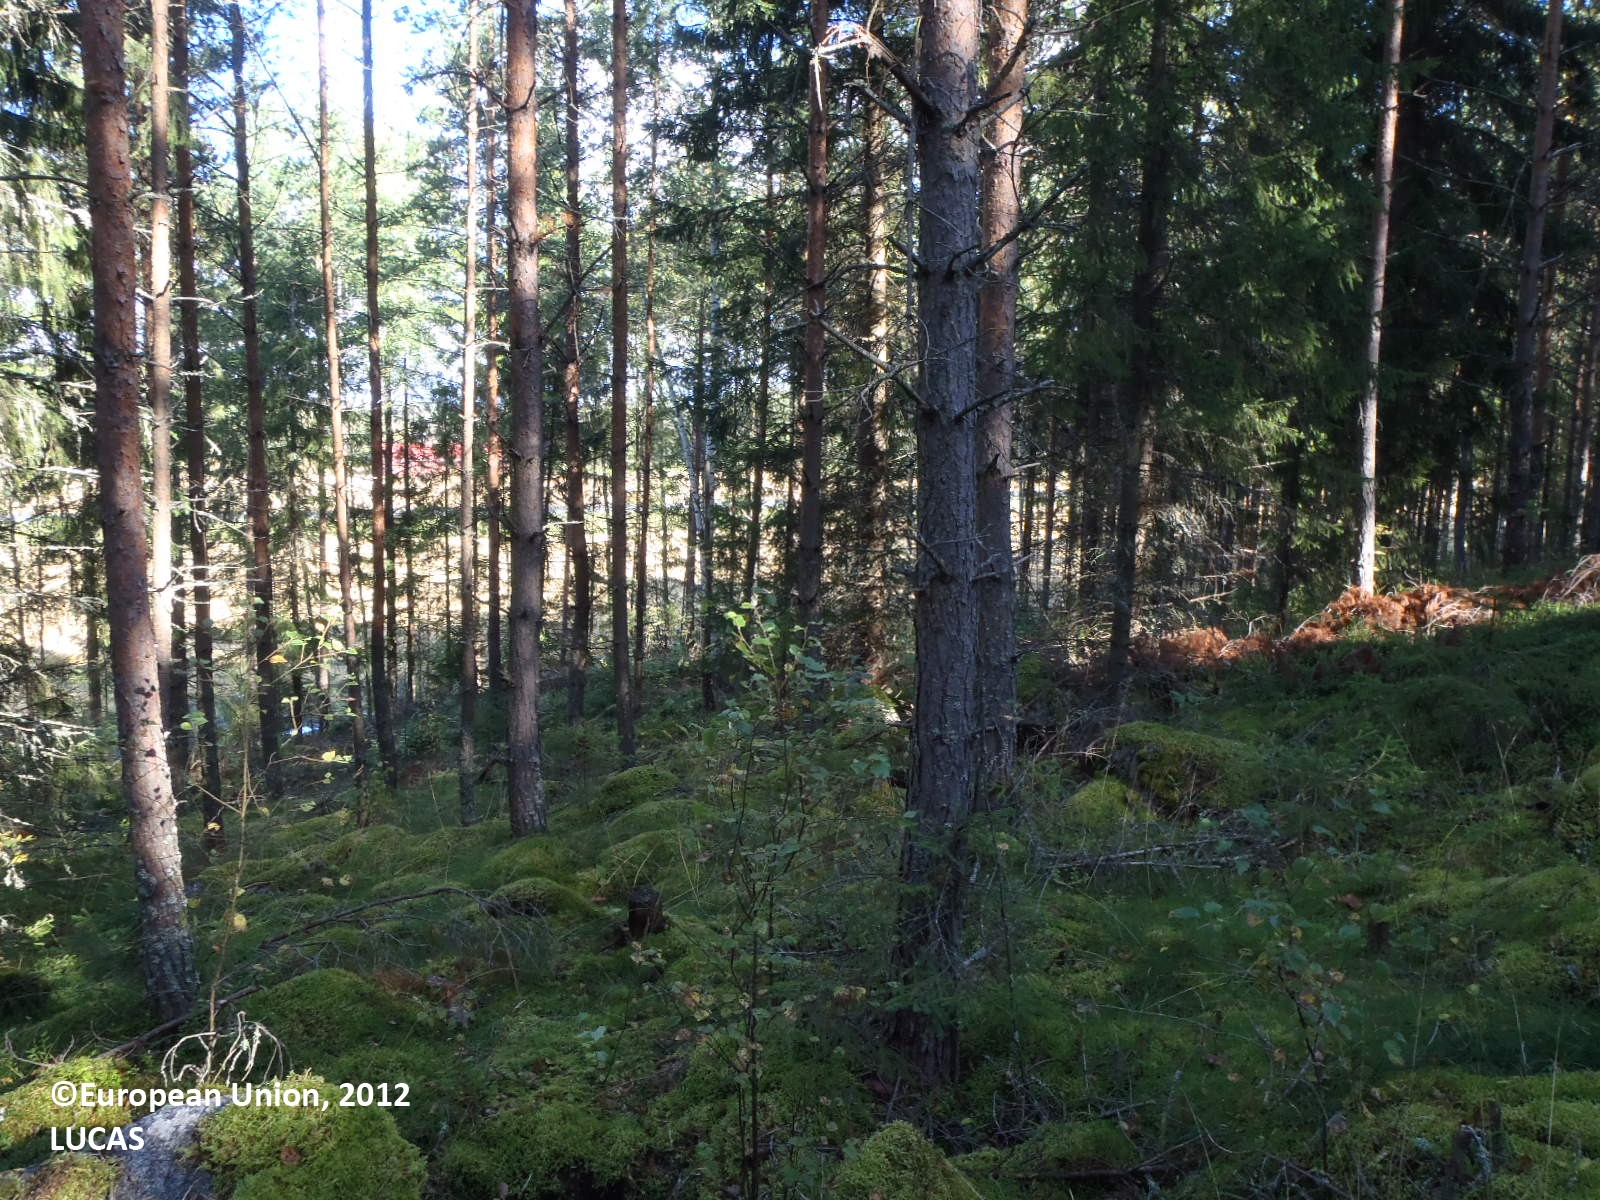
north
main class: Woodland
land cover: Pine dominated coniferous woodland
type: boreal forest
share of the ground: 50 - 75 %
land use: Forestry
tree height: > 5 m
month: September
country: FI
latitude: 61.2964
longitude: 22.7799
